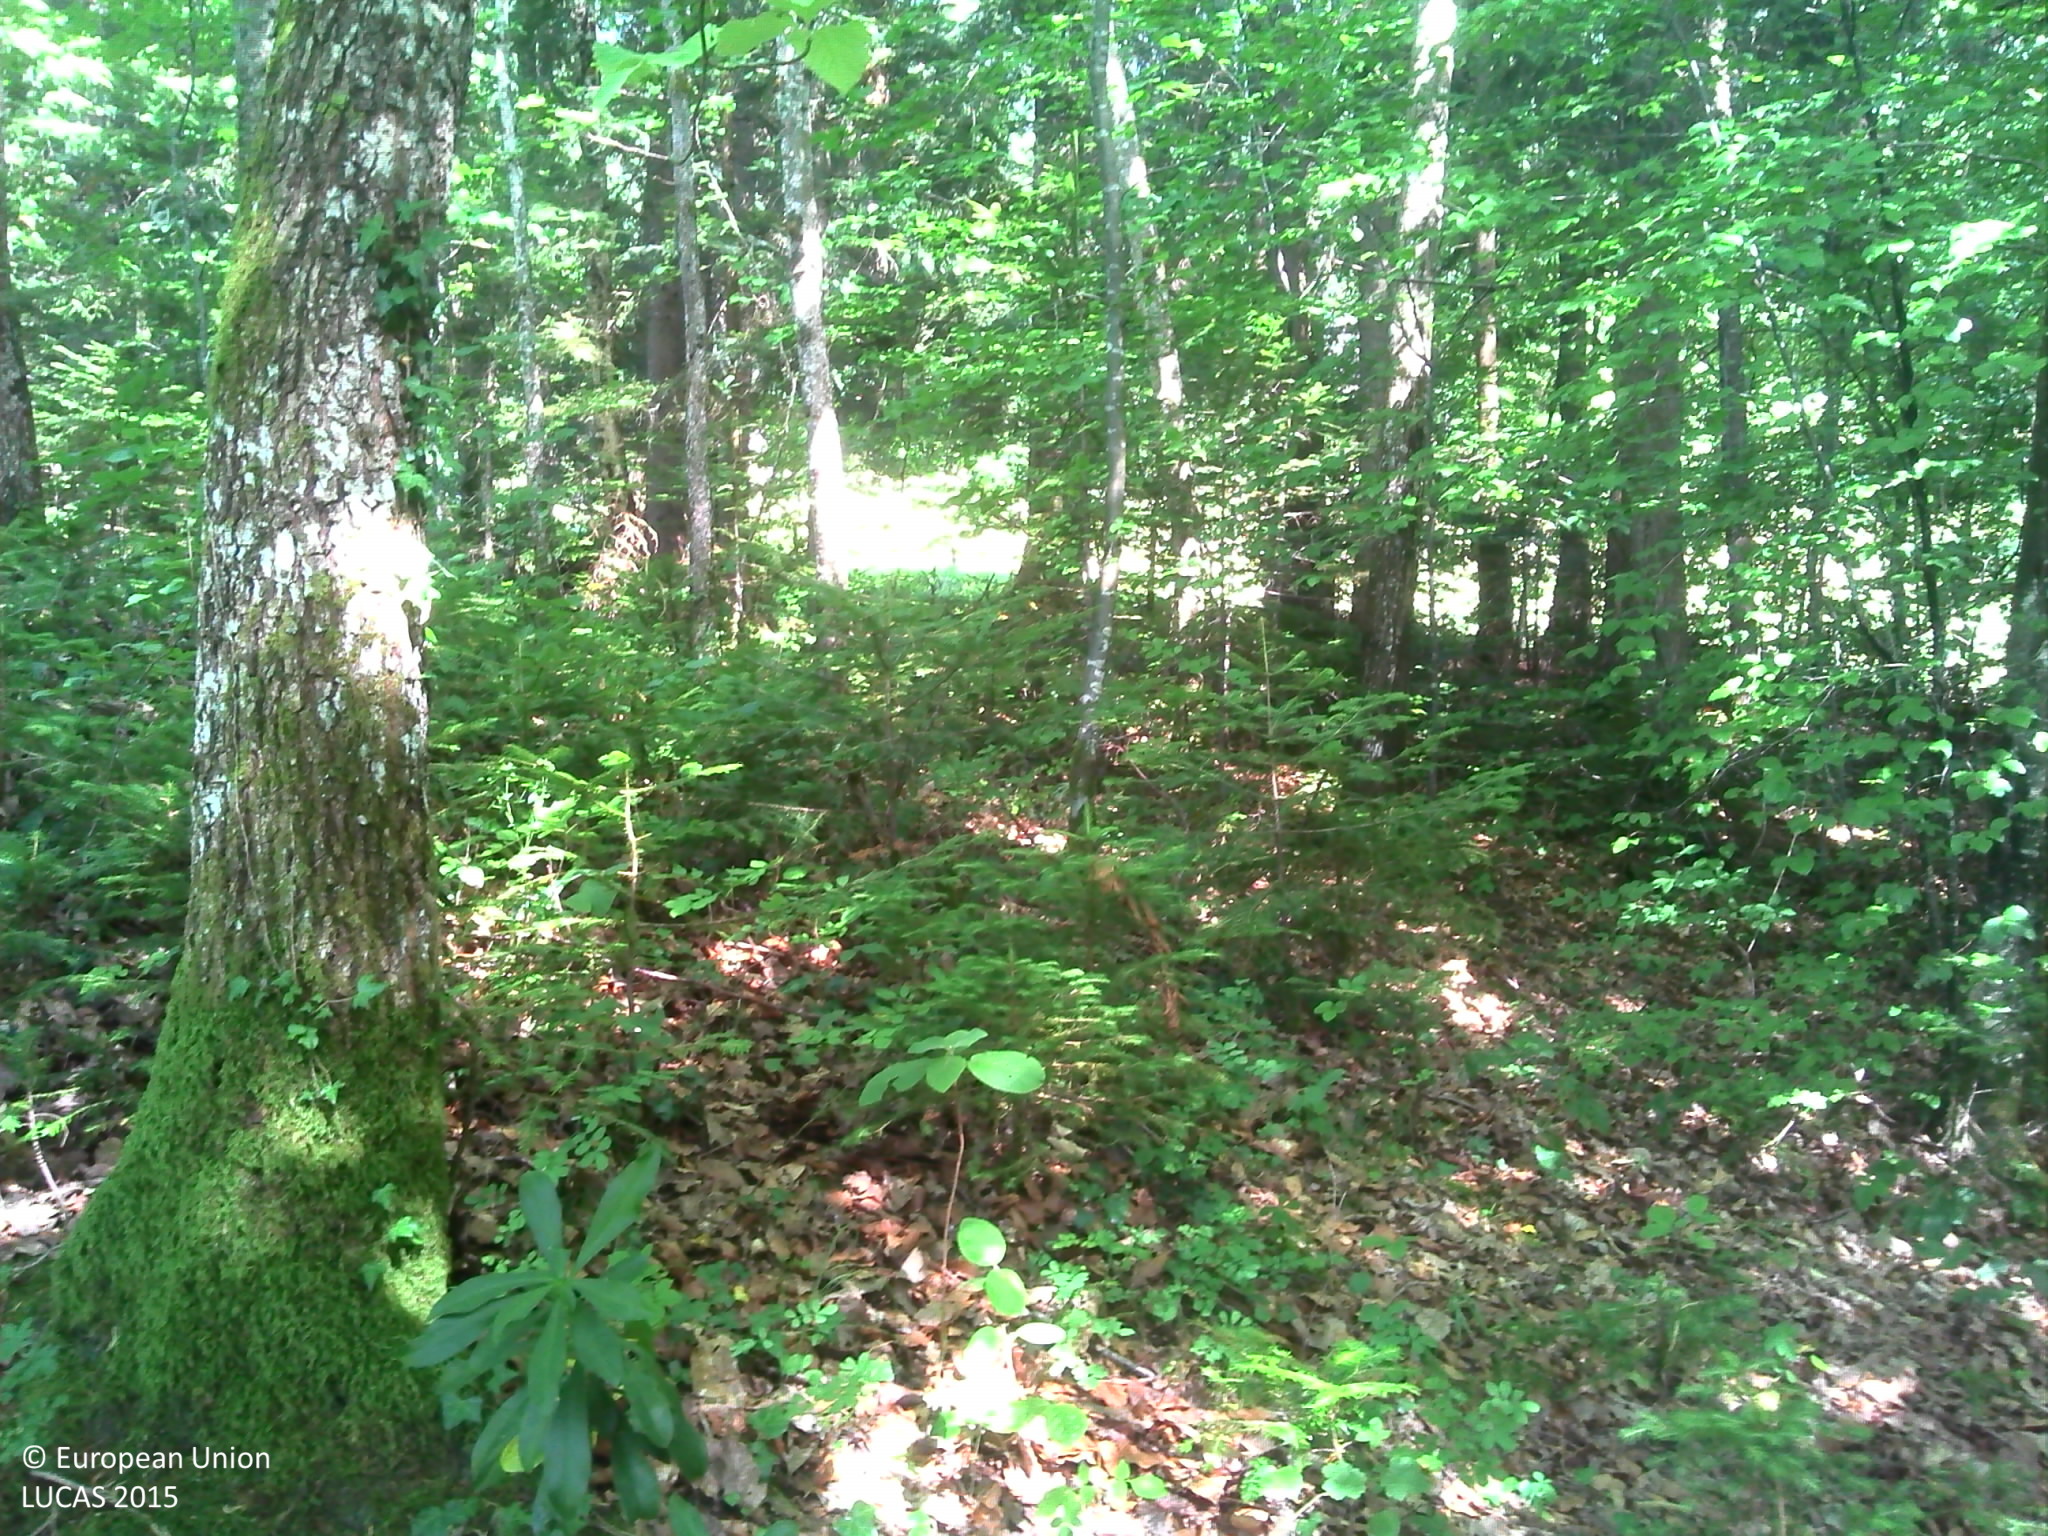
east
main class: Woodland
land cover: Spruce dominated mixed woodland
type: mountainous beech forest
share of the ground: > 75 %
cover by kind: broadleaved forest trees 40 %, coniferous forest trees 35 %, herbaceous plants 20 %, lichens and mosses 5 %
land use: Forestry
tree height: > 5 m
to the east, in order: Spruce dominated mixed woodland; Tracks; Fences; Grassland without tree/shrub cover; Fences; Tracks; Spruce dominated mixed woodland; Tracks; Fences; Grassland without tree/shrub cover
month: July
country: FR
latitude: 45.7288
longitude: 6.3164
